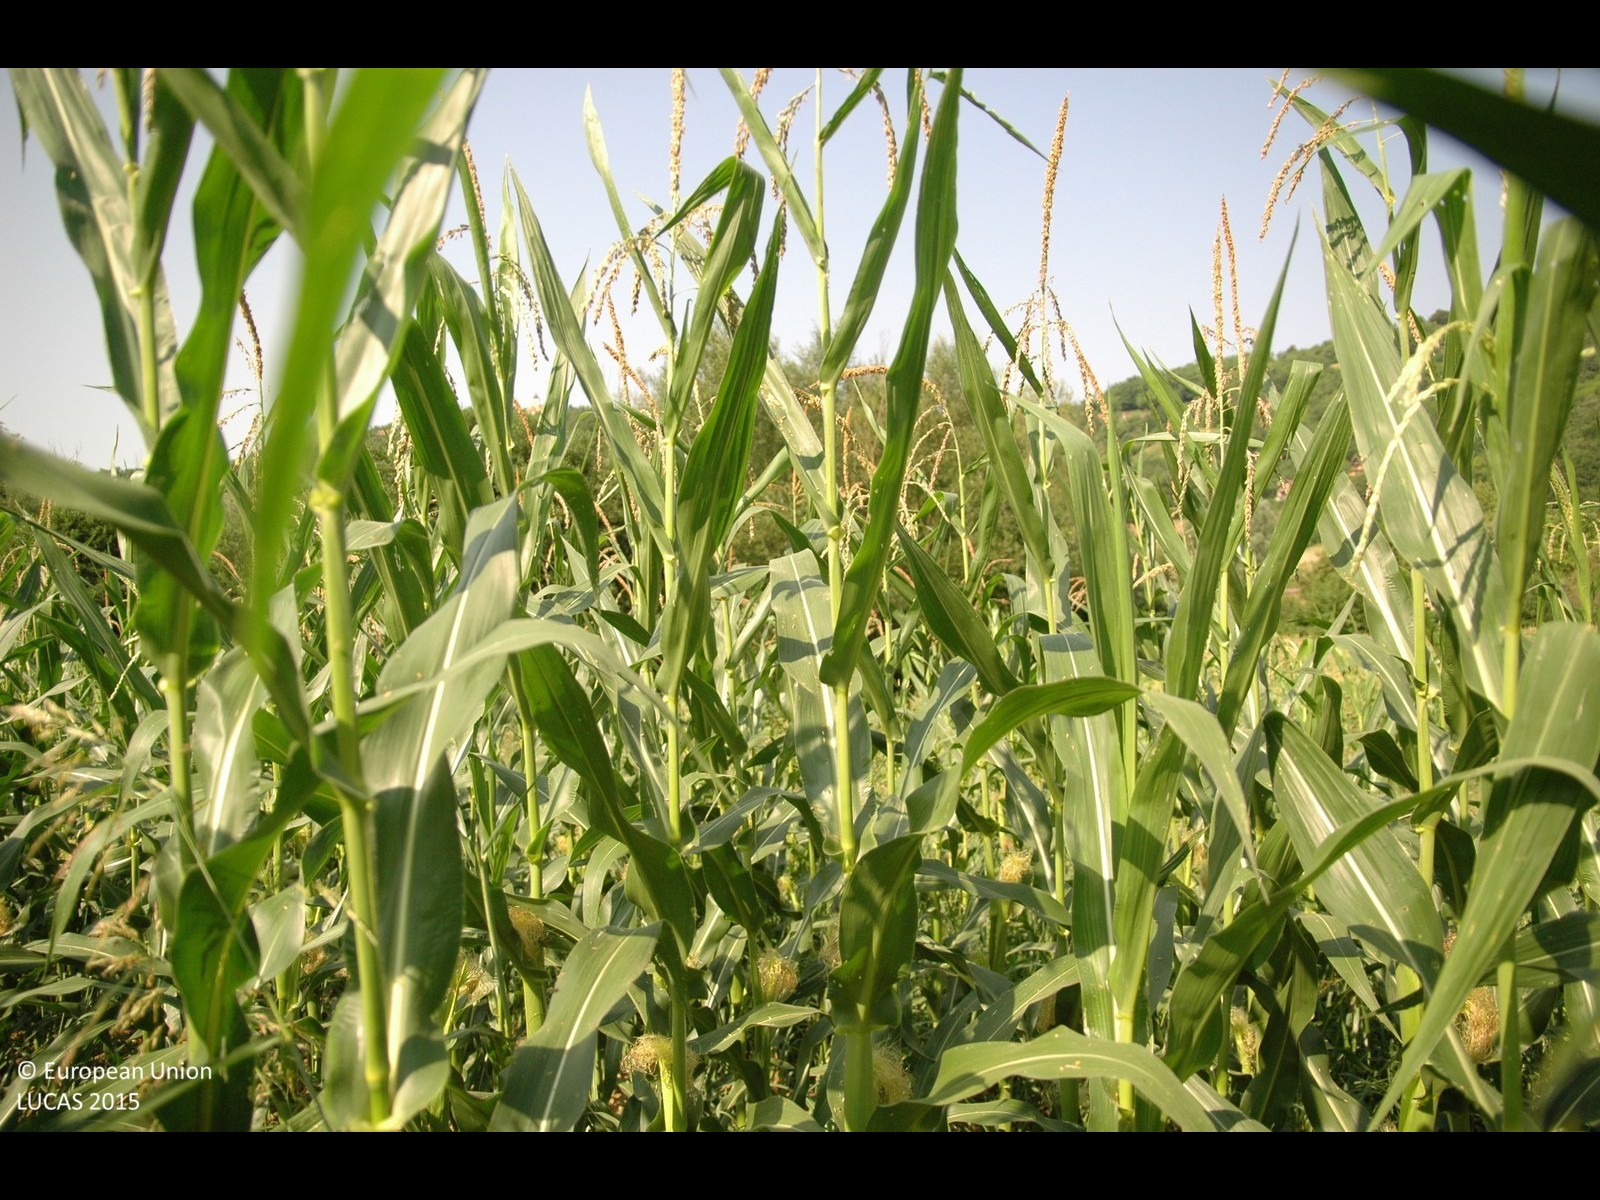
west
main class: Cropland
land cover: Maize
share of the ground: > 75 %
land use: Agriculture (excluding fallow land and kitchen gardens)
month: July
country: HR
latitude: 46.1097
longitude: 16.0149
